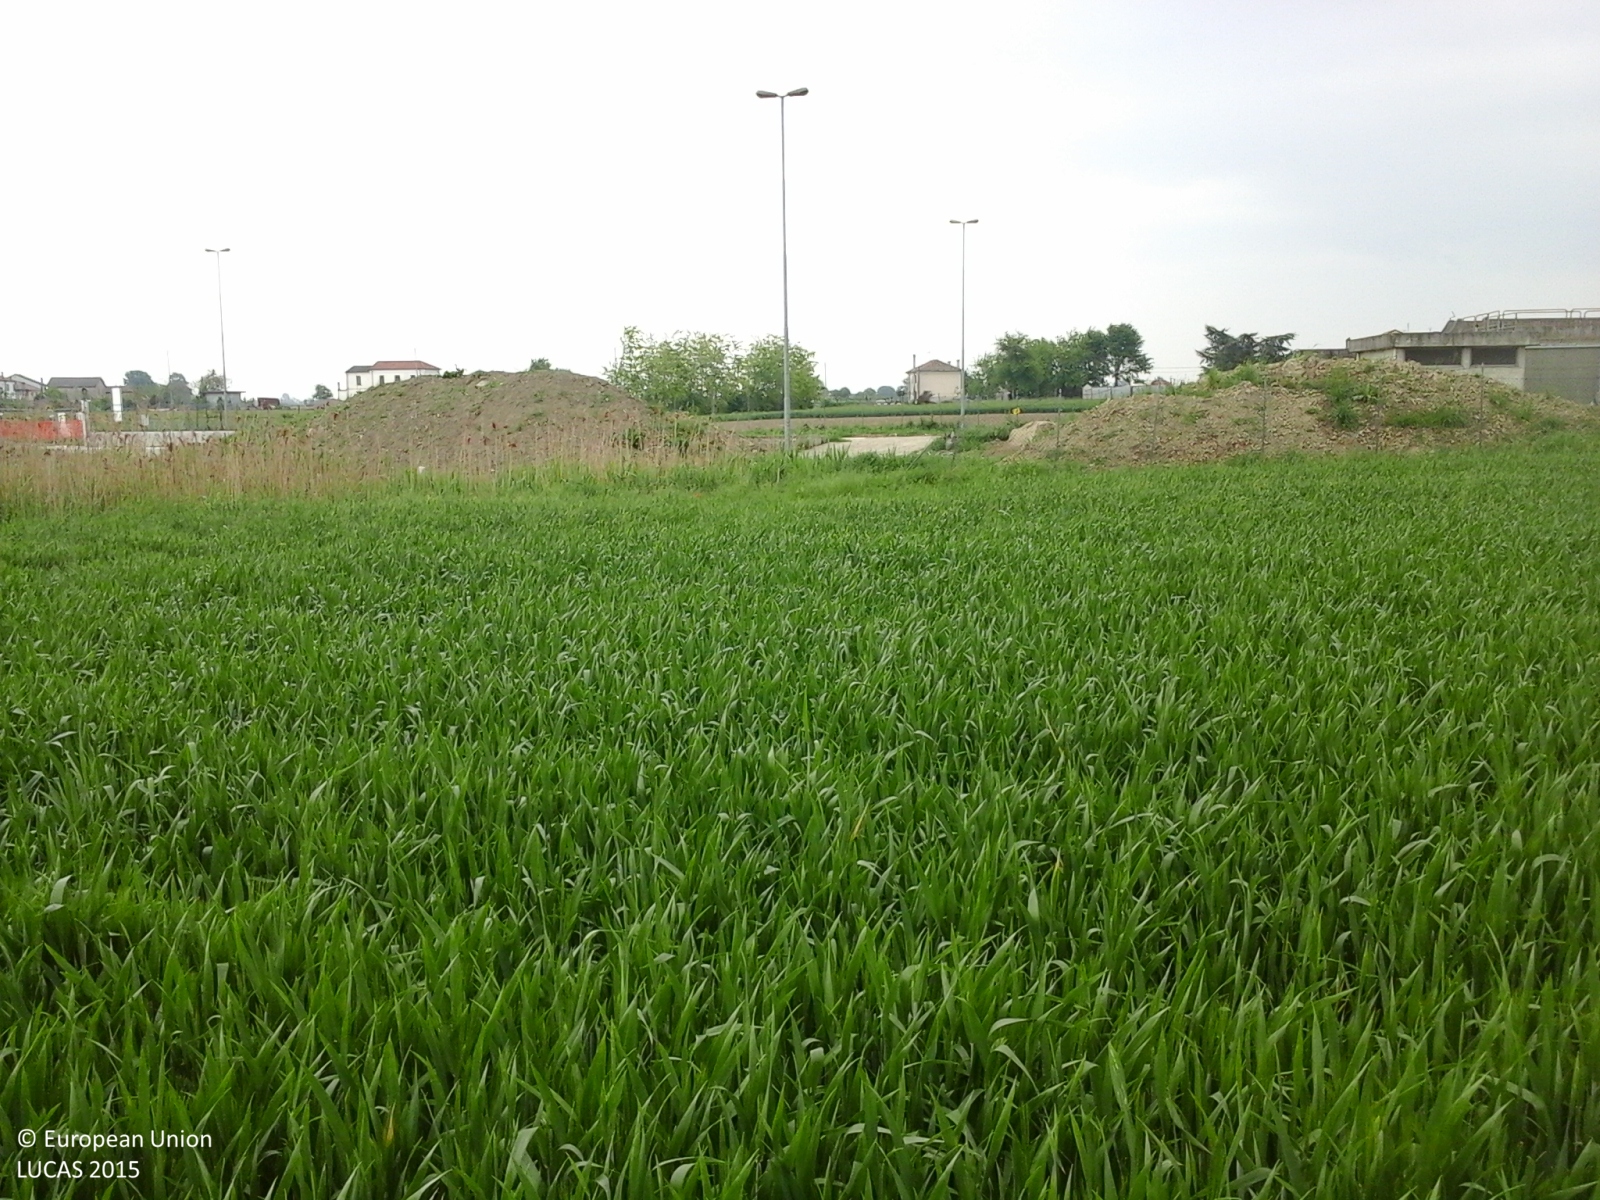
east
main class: Cropland
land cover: Common wheat
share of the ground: > 75 %
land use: Agriculture (excluding fallow land and kitchen gardens)
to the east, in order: Common wheat; Spontaneously vegetated surfaces; Artificial constructions in urban areas; Other bare soil; Ditches and canals; Paved roads, cycling and walking lanes; Grass margins; Ditches and canals; Vineyards; Other fresh vegetables; Maize; Artificial constructions in urban areas
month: May
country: IT
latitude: 44.9694
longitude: 11.6072
